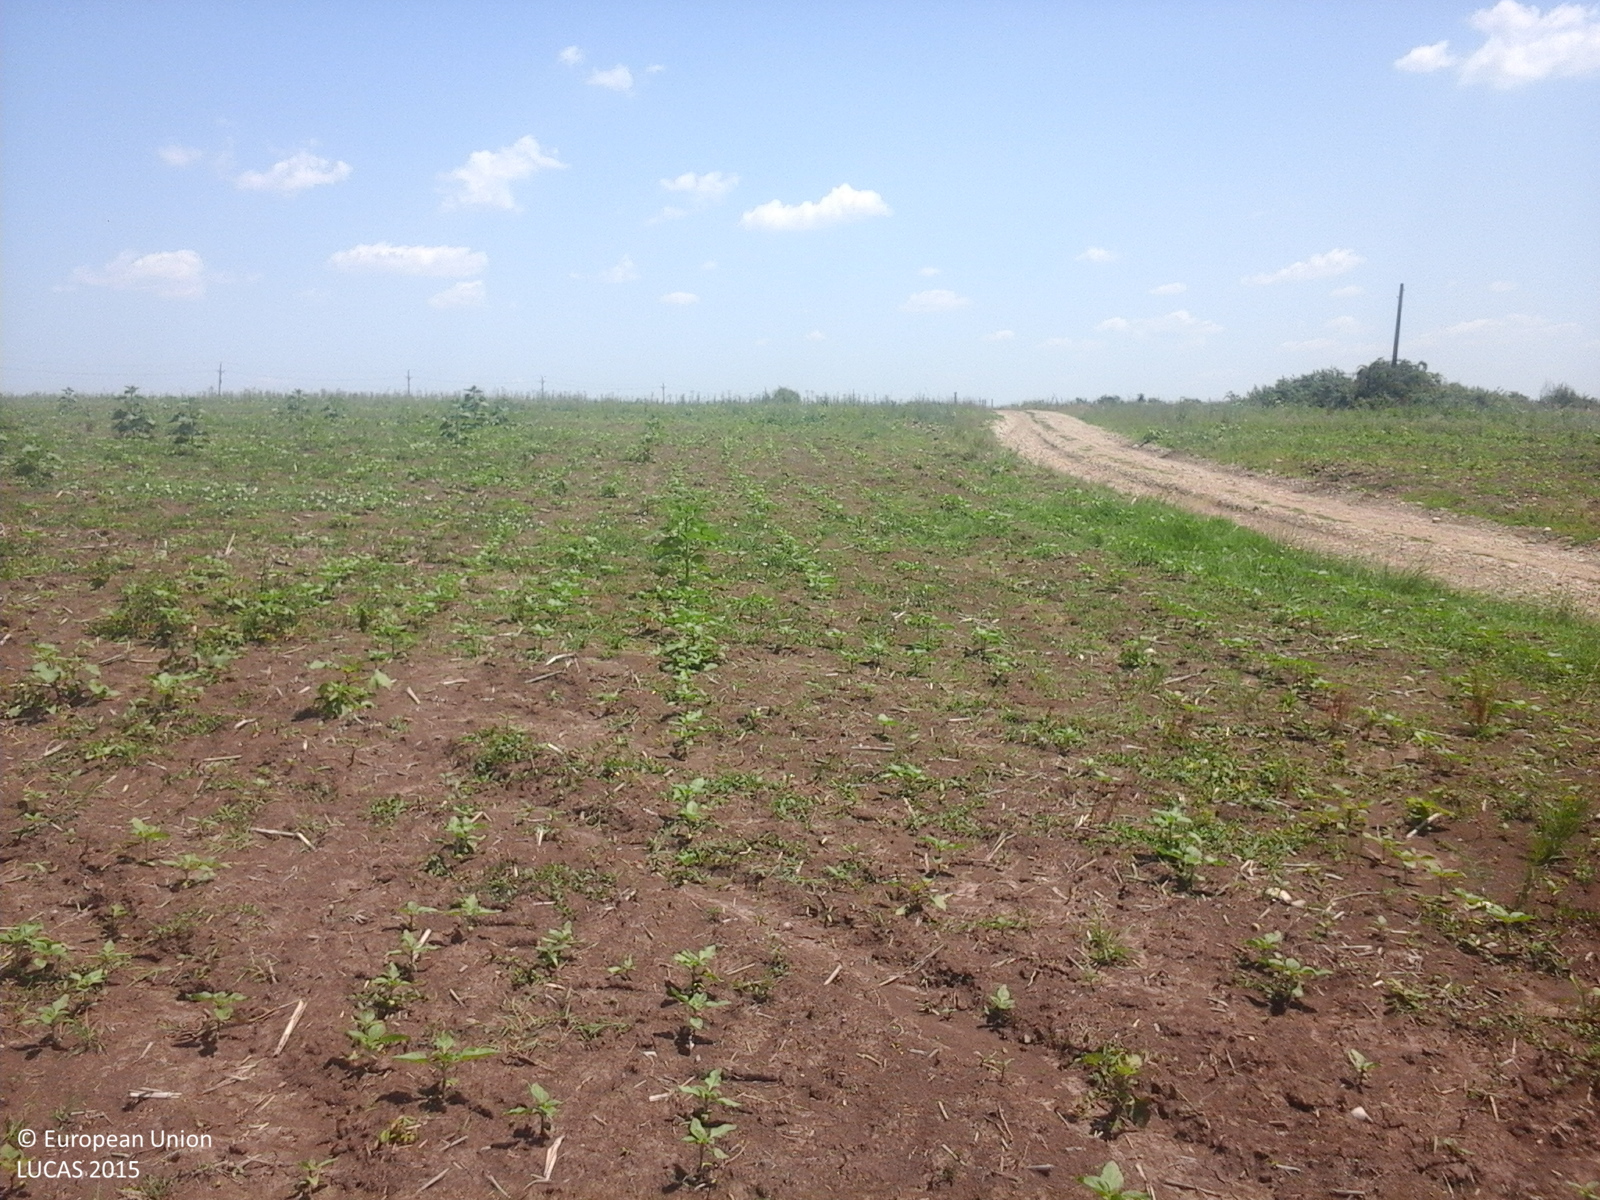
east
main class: Cropland
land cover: Sunflower
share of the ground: < 10 %
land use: Agriculture (excluding fallow land and kitchen gardens)
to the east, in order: Sunflower; Maize; Sunflower; Maize; Other bare soil; Maize; Grass margins; Tracks; Spontaneously vegetated surfaces
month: July
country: RO
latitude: 44.4342
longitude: 24.6847
